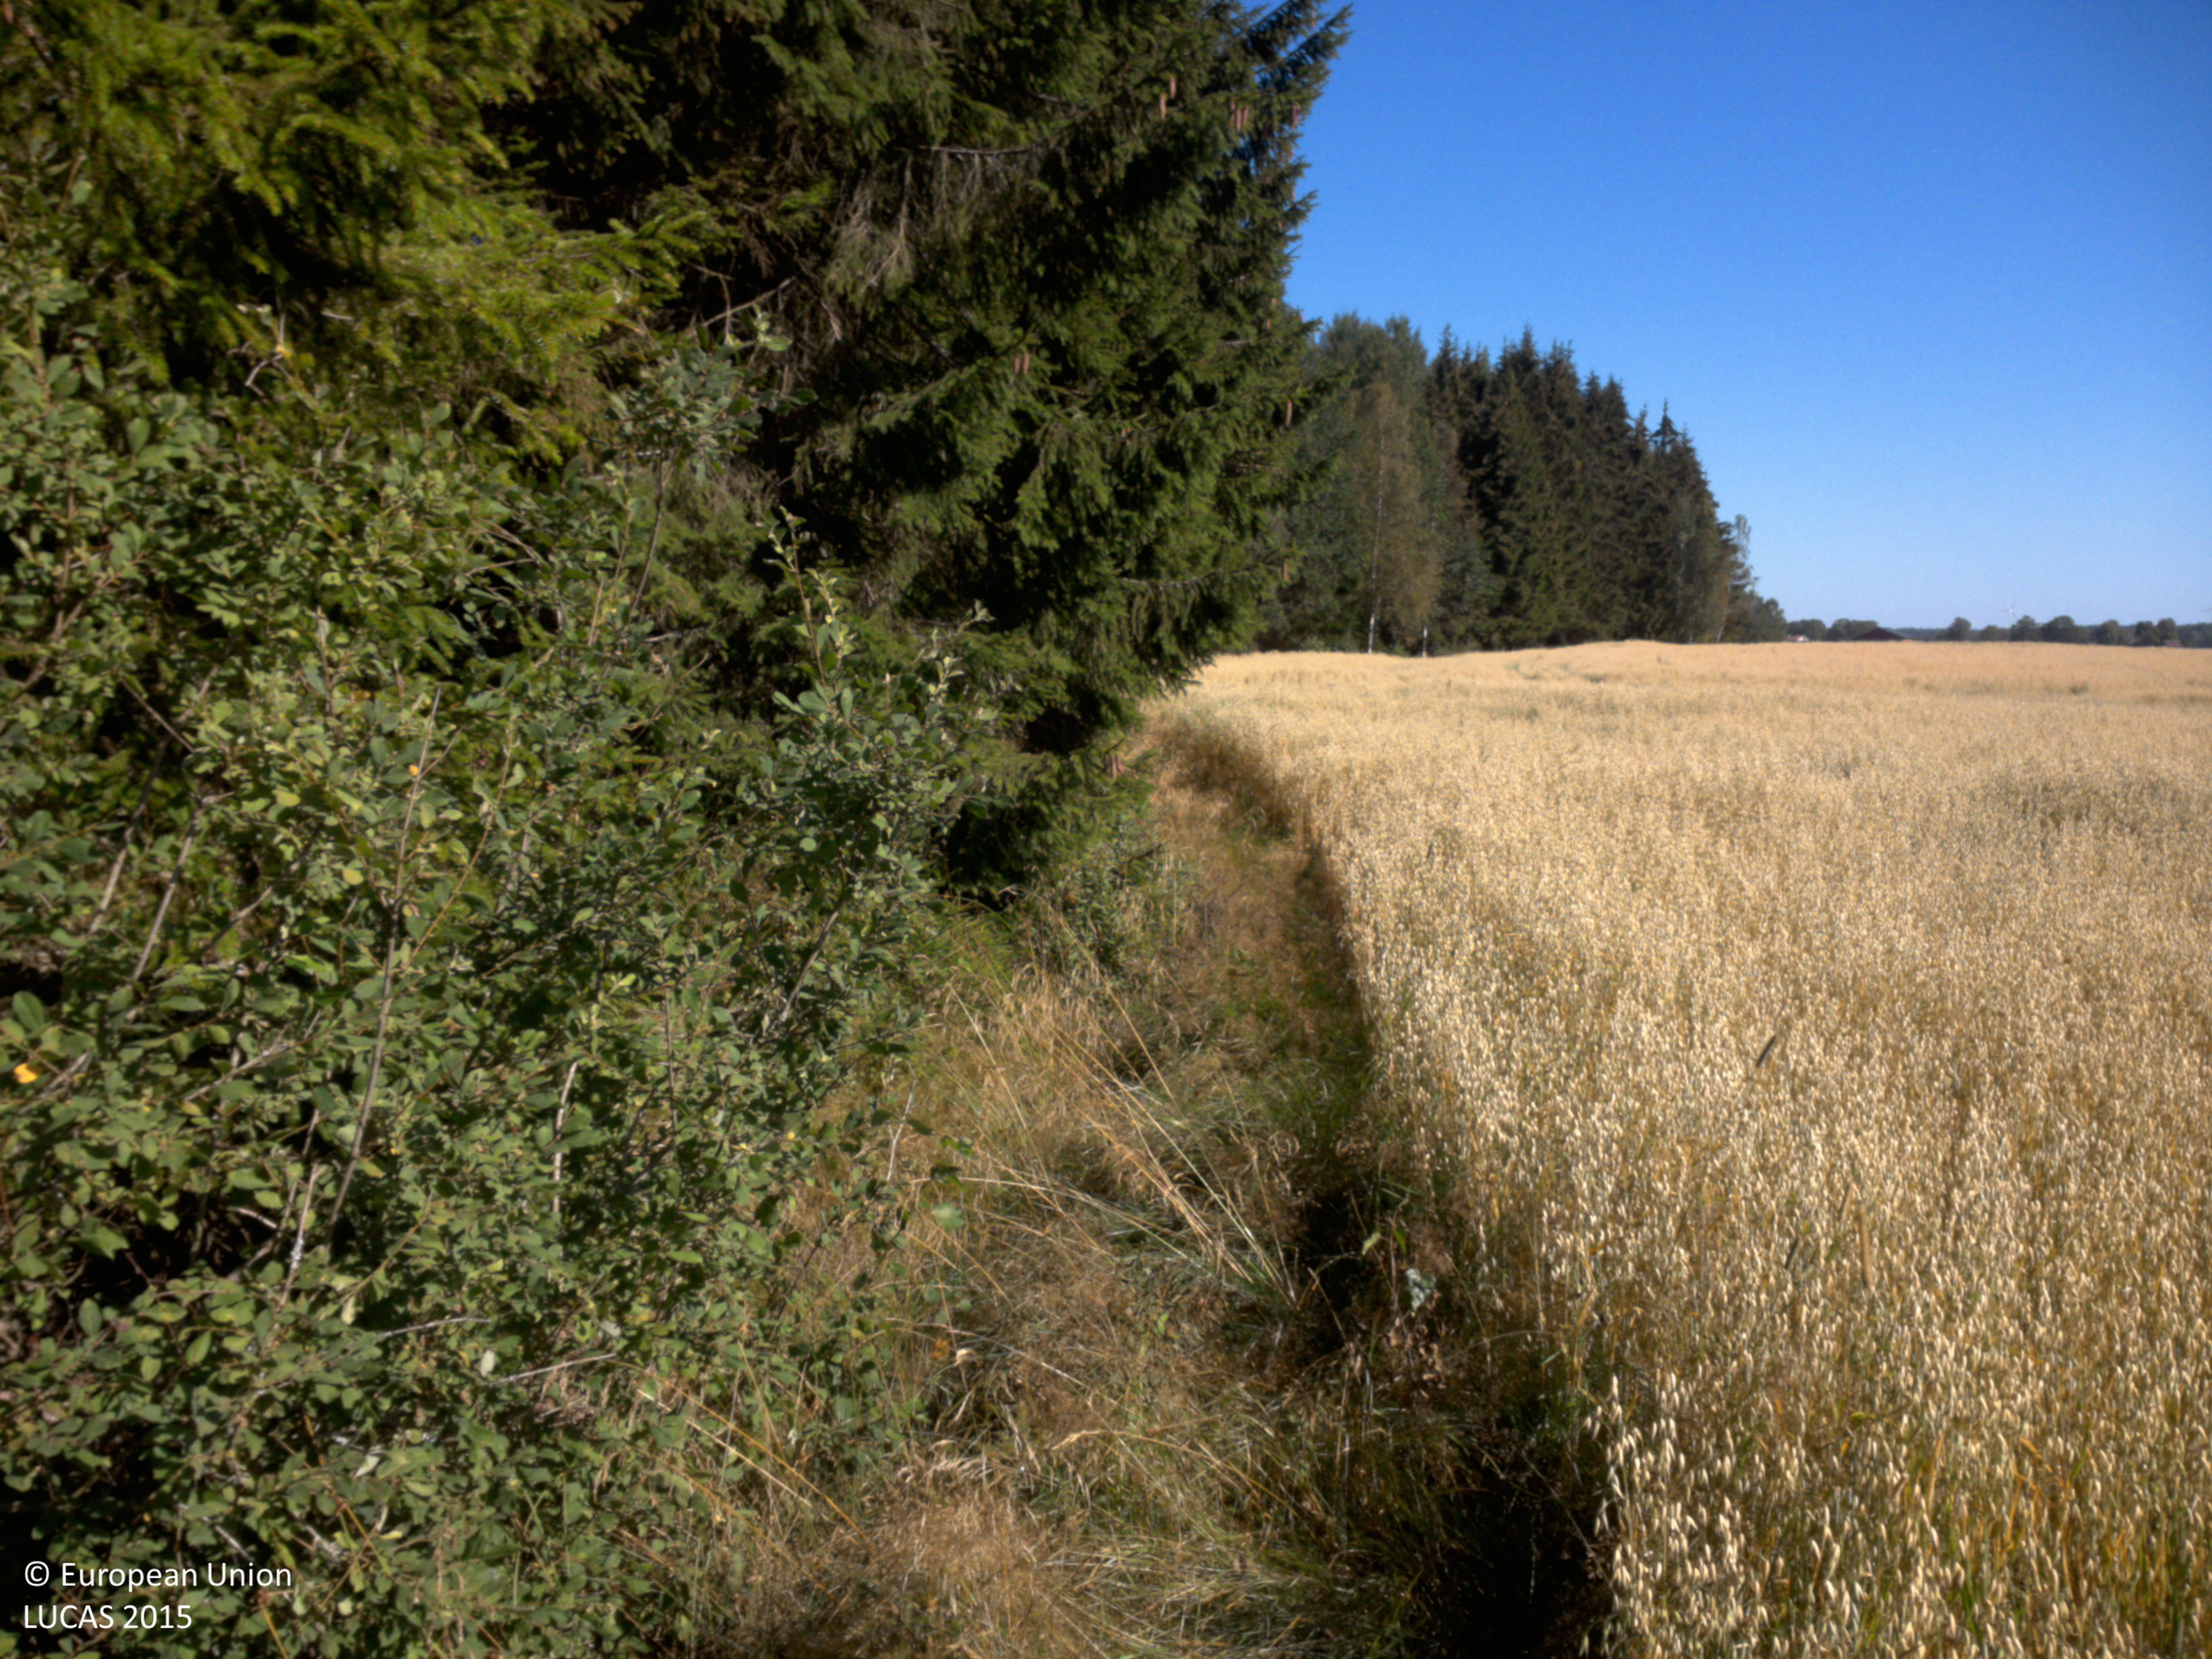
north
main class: Cropland
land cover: Oats
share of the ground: > 75 %
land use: Agriculture (excluding fallow land and kitchen gardens)
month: August
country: SE
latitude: 58.6134
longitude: 12.3192
